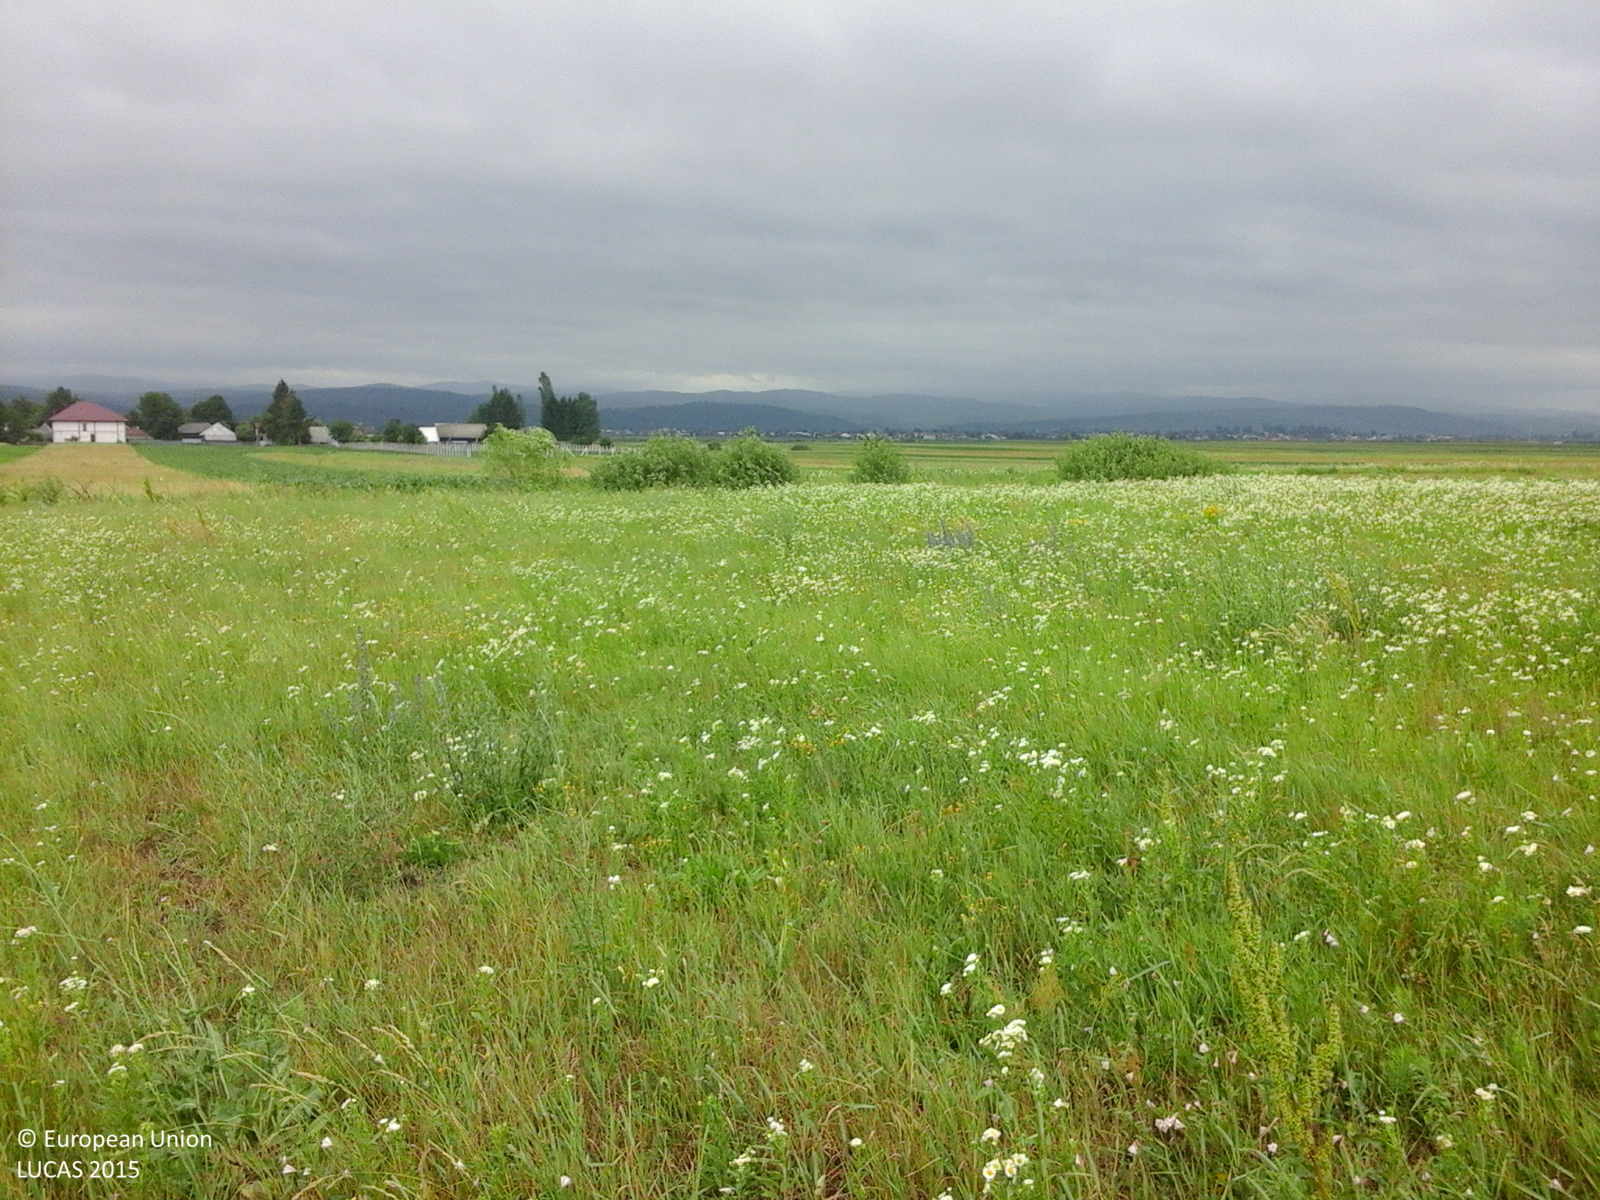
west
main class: Grassland
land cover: Grassland without tree/shrub cover
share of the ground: > 75 %
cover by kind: herbaceous plants 100 %
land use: Agriculture (excluding fallow land and kitchen gardens)
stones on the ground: < 10 %
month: June
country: RO
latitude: 47.4264
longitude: 26.2686
